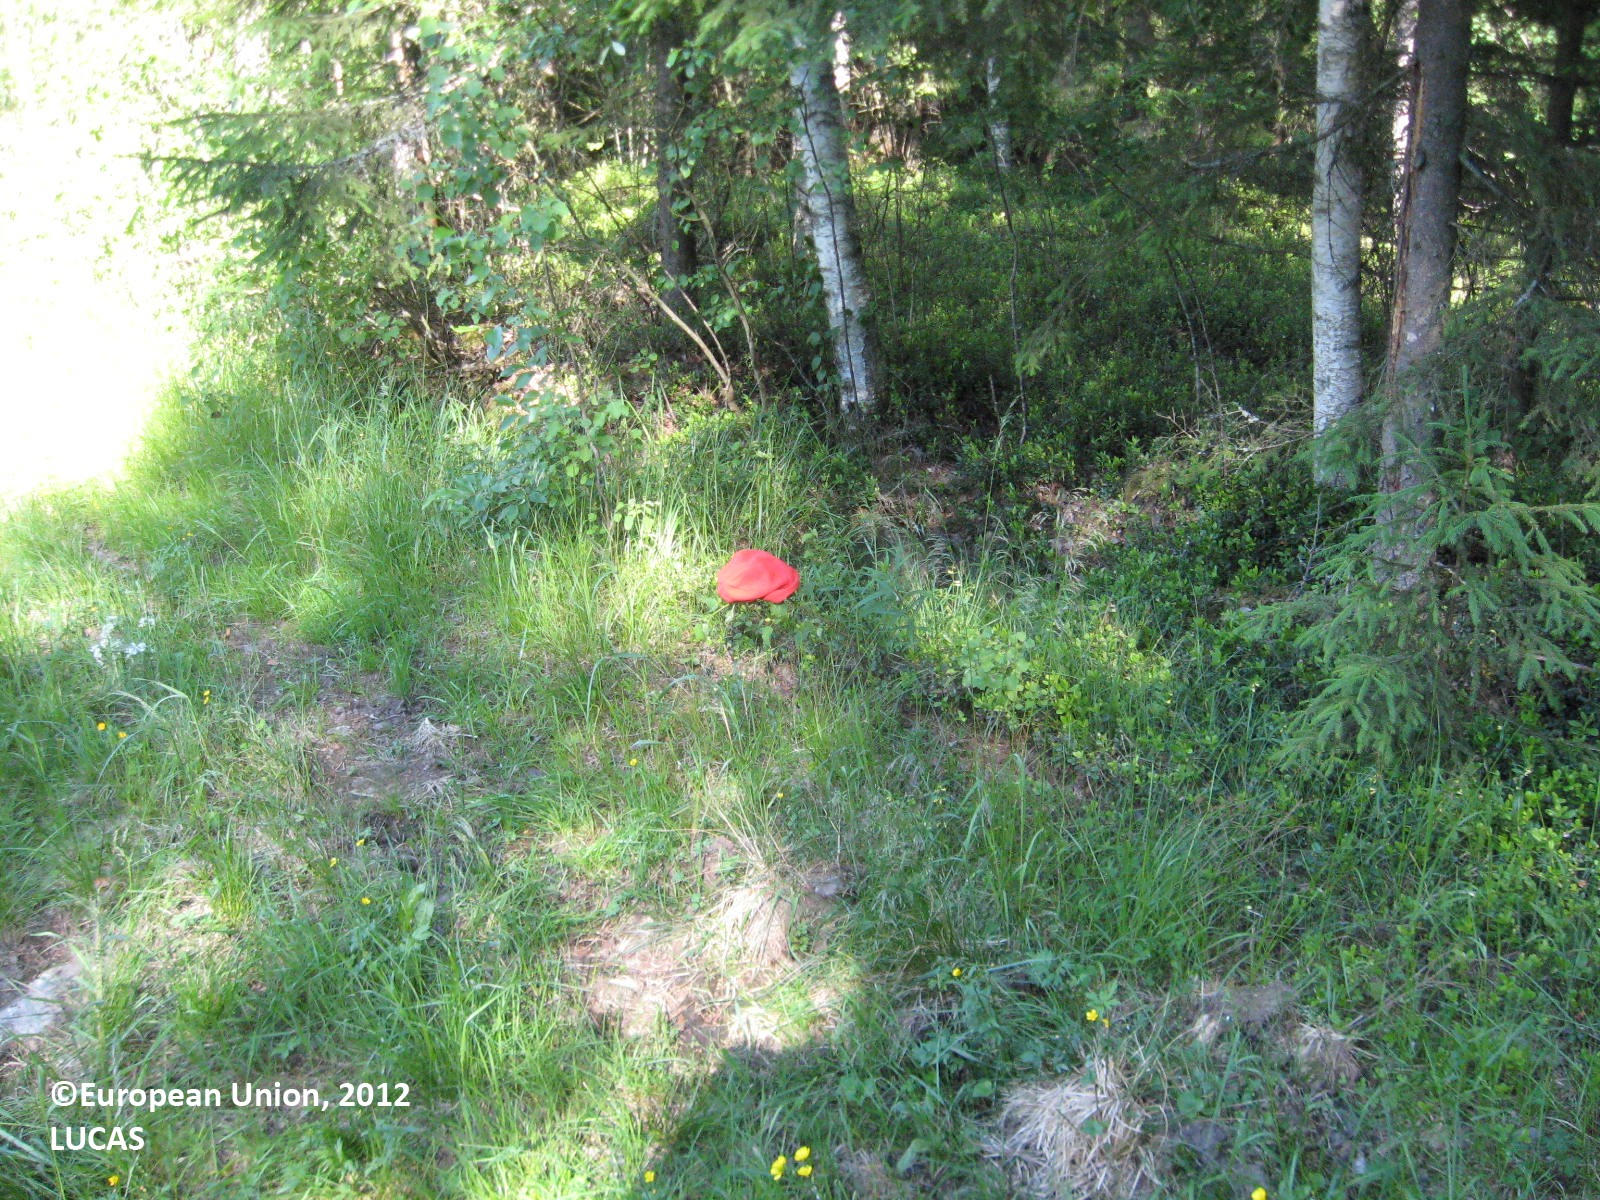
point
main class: Woodland
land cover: Pine dominated mixed woodland
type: boreal forest
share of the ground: > 75 %
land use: Forestry
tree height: > 5 m
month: July
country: FI
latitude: 62.5932
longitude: 22.8144
